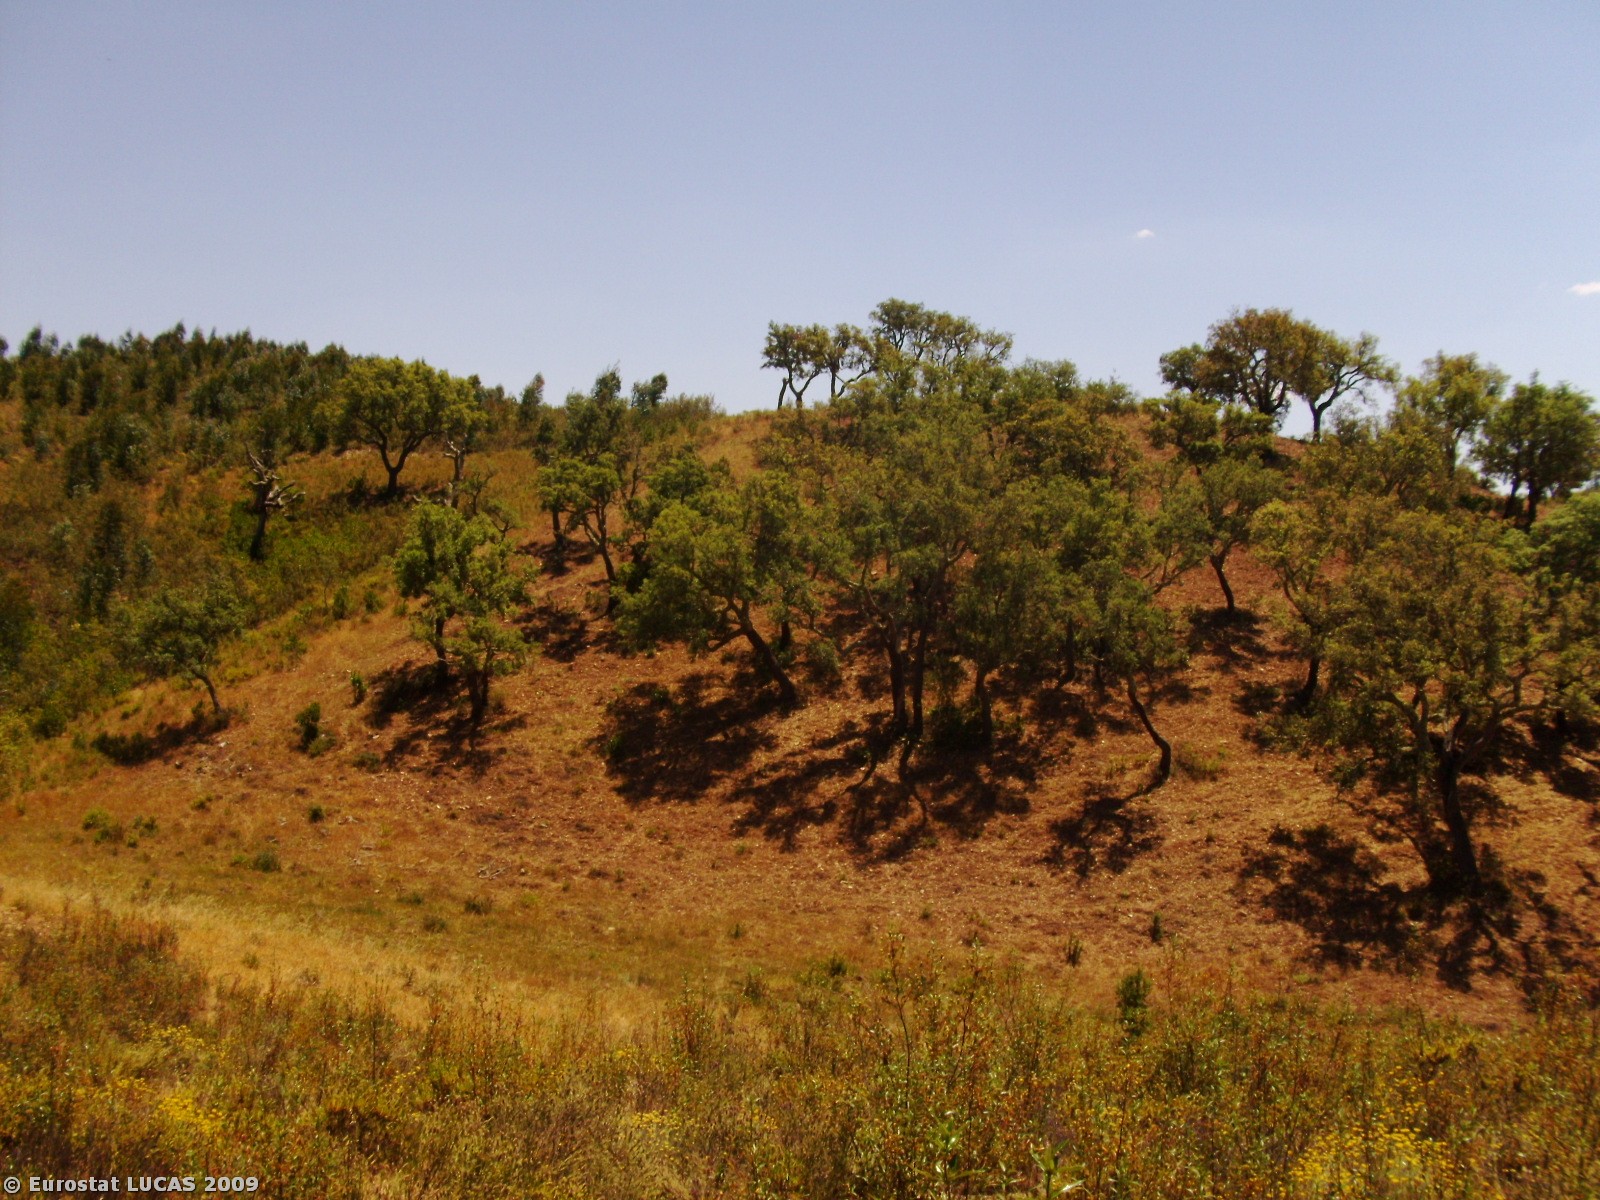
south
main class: Shrubland
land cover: Shrubland without tree cover
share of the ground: 50 - 75 %
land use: Unused
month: May
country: PT
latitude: 37.4676
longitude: -8.2404
